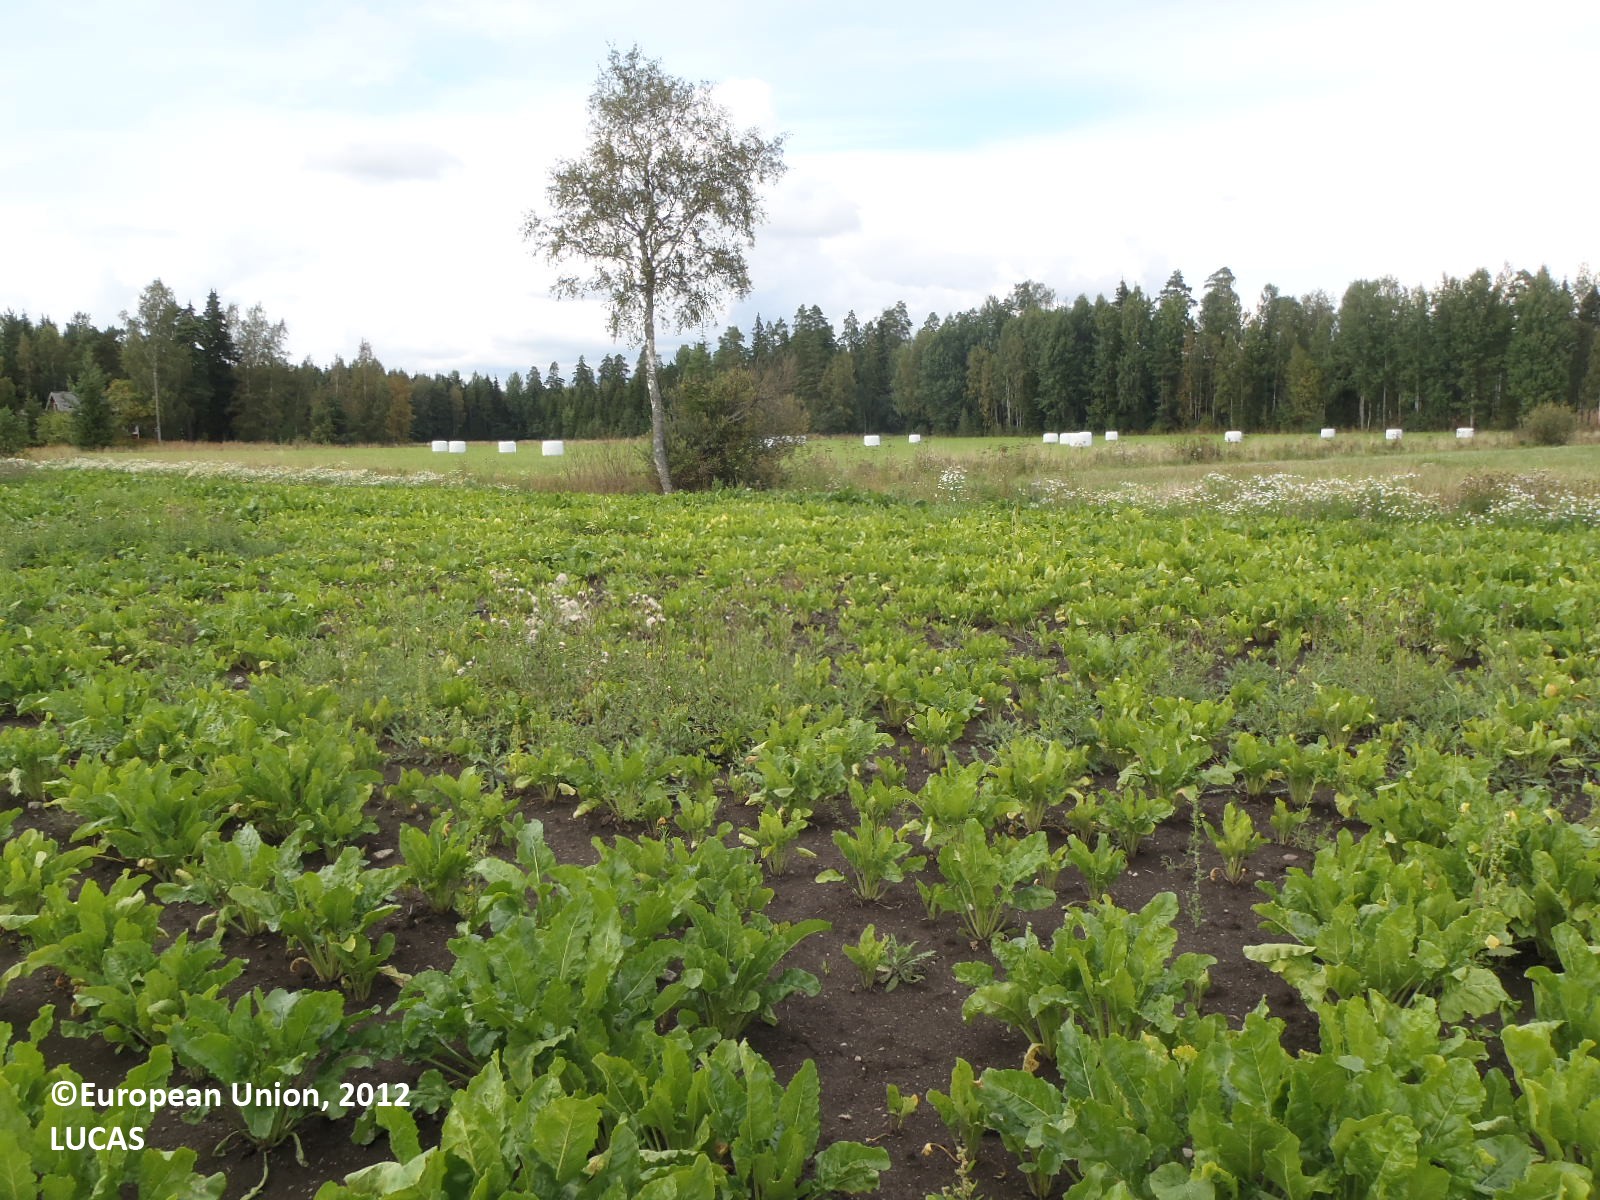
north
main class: Cropland
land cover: Sugar beet
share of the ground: > 75 %
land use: Agriculture (excluding fallow land and kitchen gardens)
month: August
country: FI
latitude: 60.6553
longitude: 22.3787
